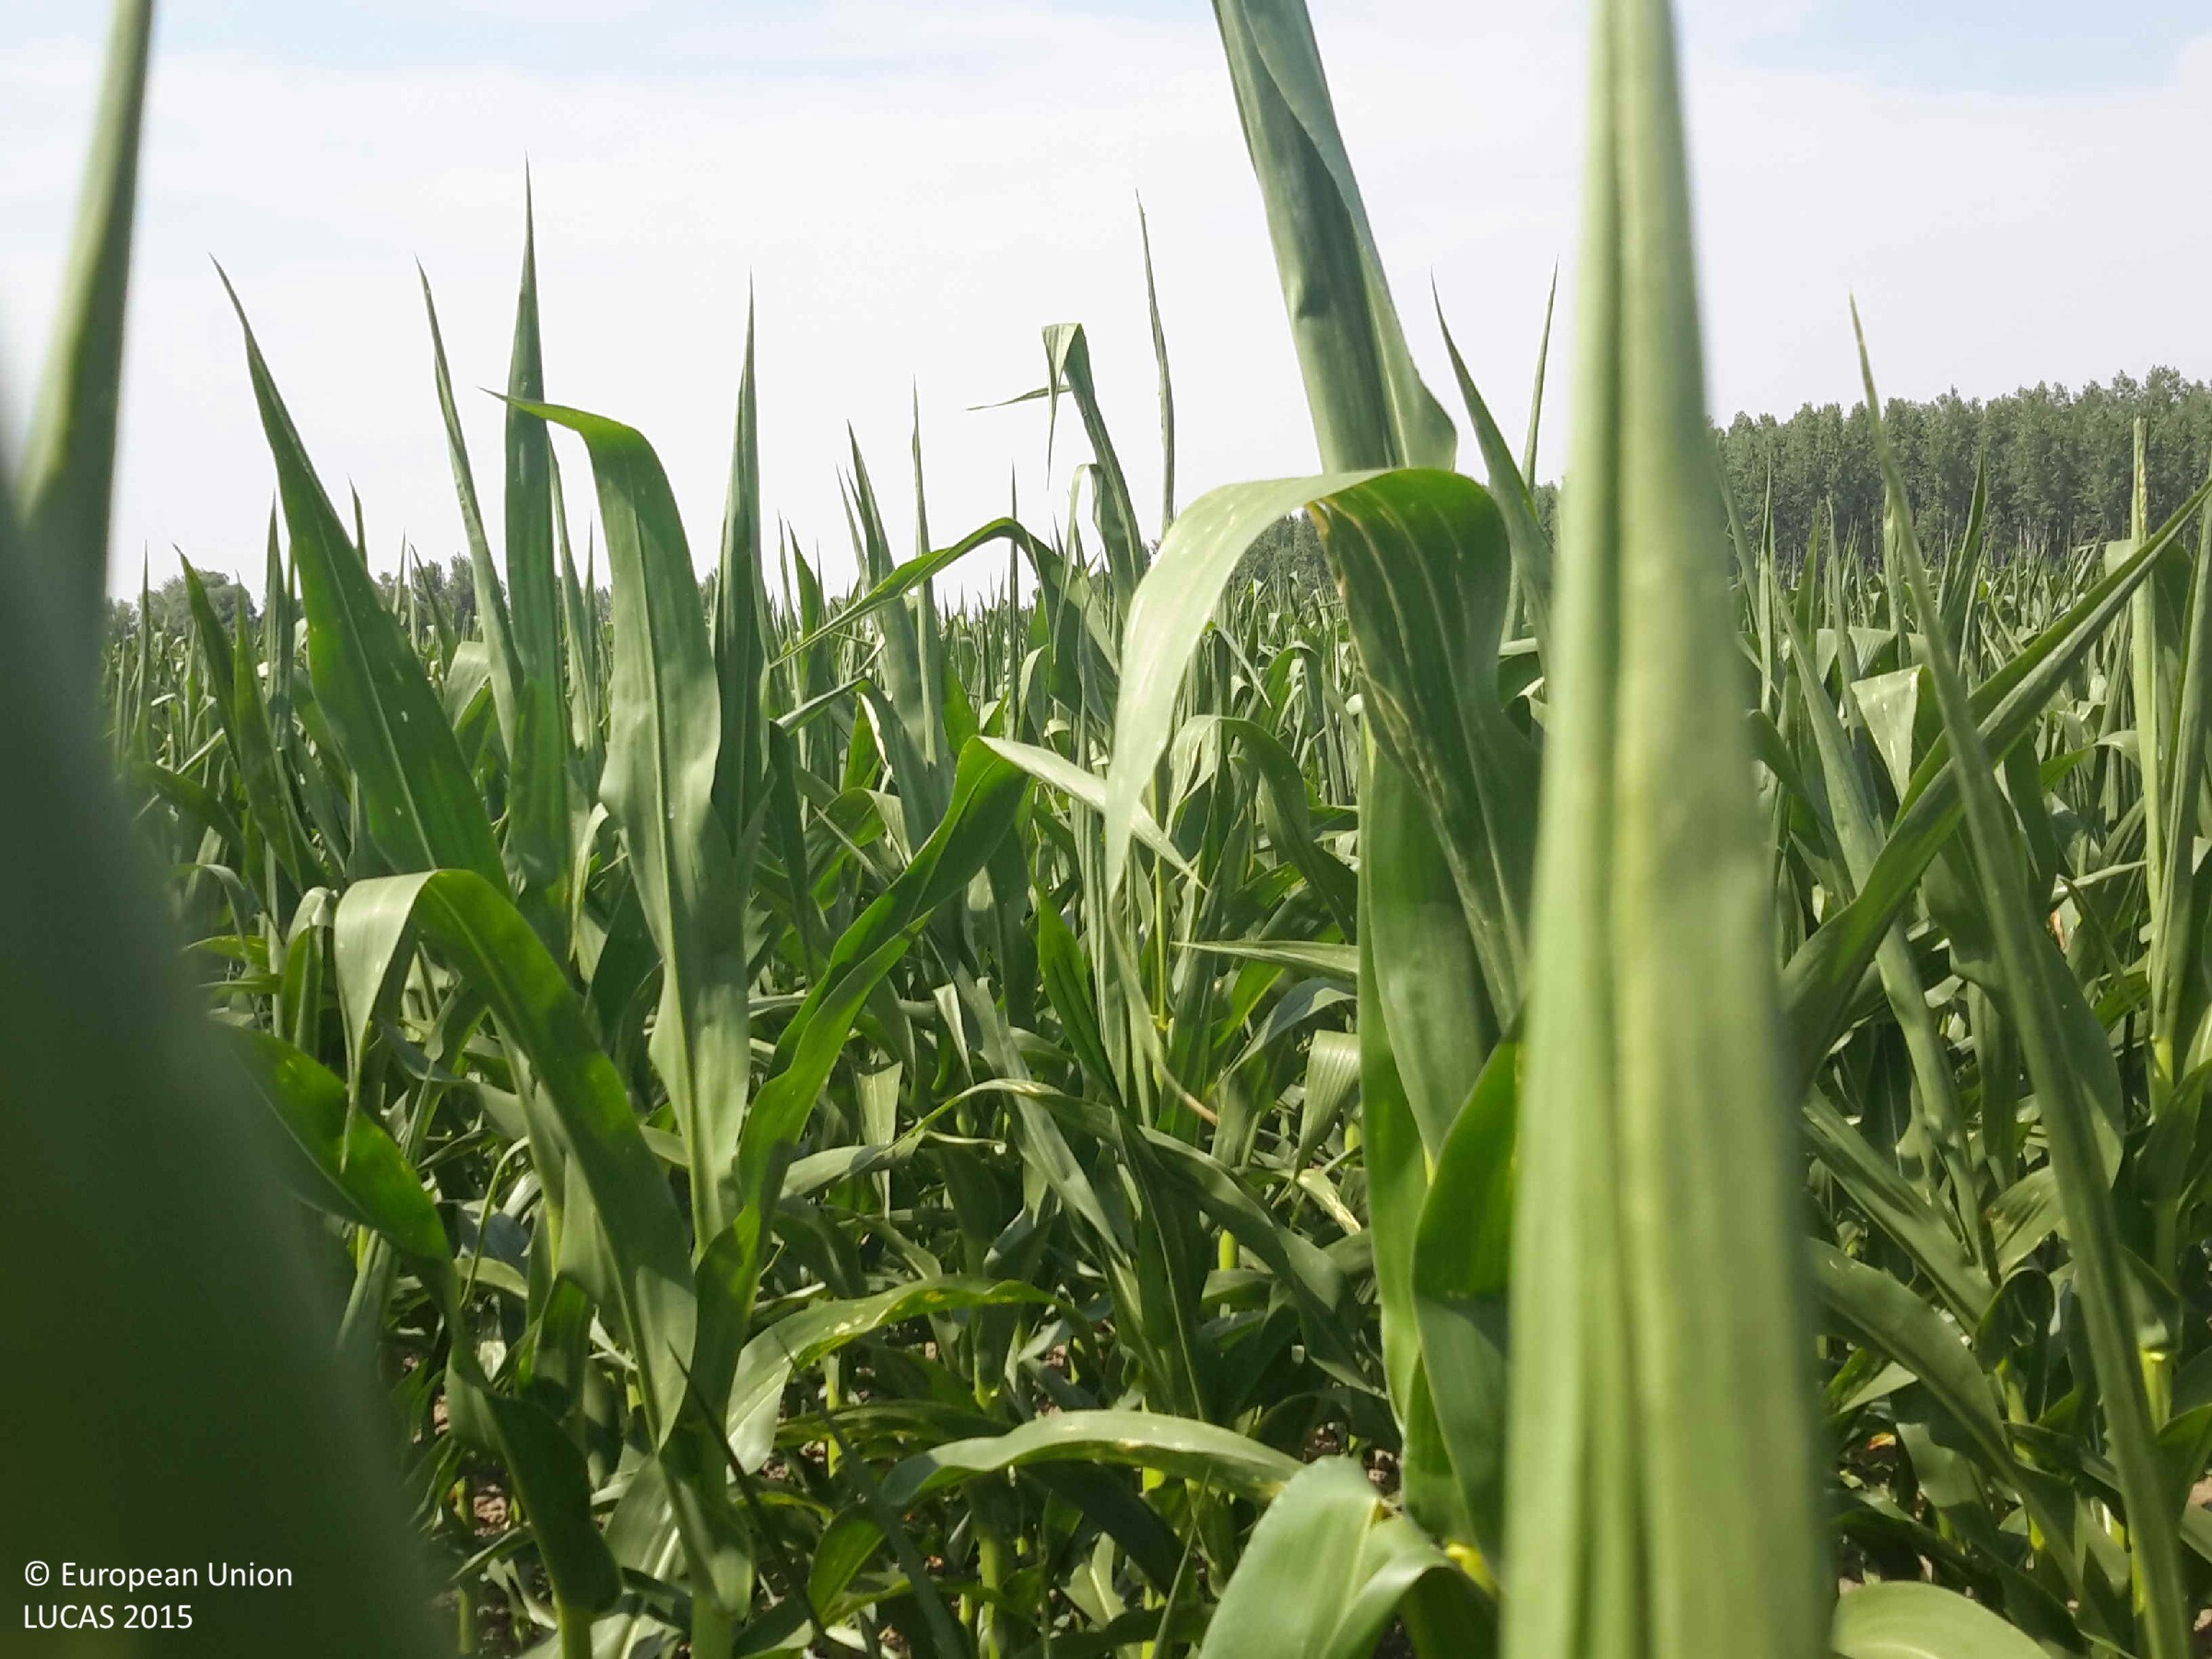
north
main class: Cropland
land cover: Maize
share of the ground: > 75 %
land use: Agriculture (excluding fallow land and kitchen gardens)
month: July
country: HU
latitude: 47.2826
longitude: 17.2114
